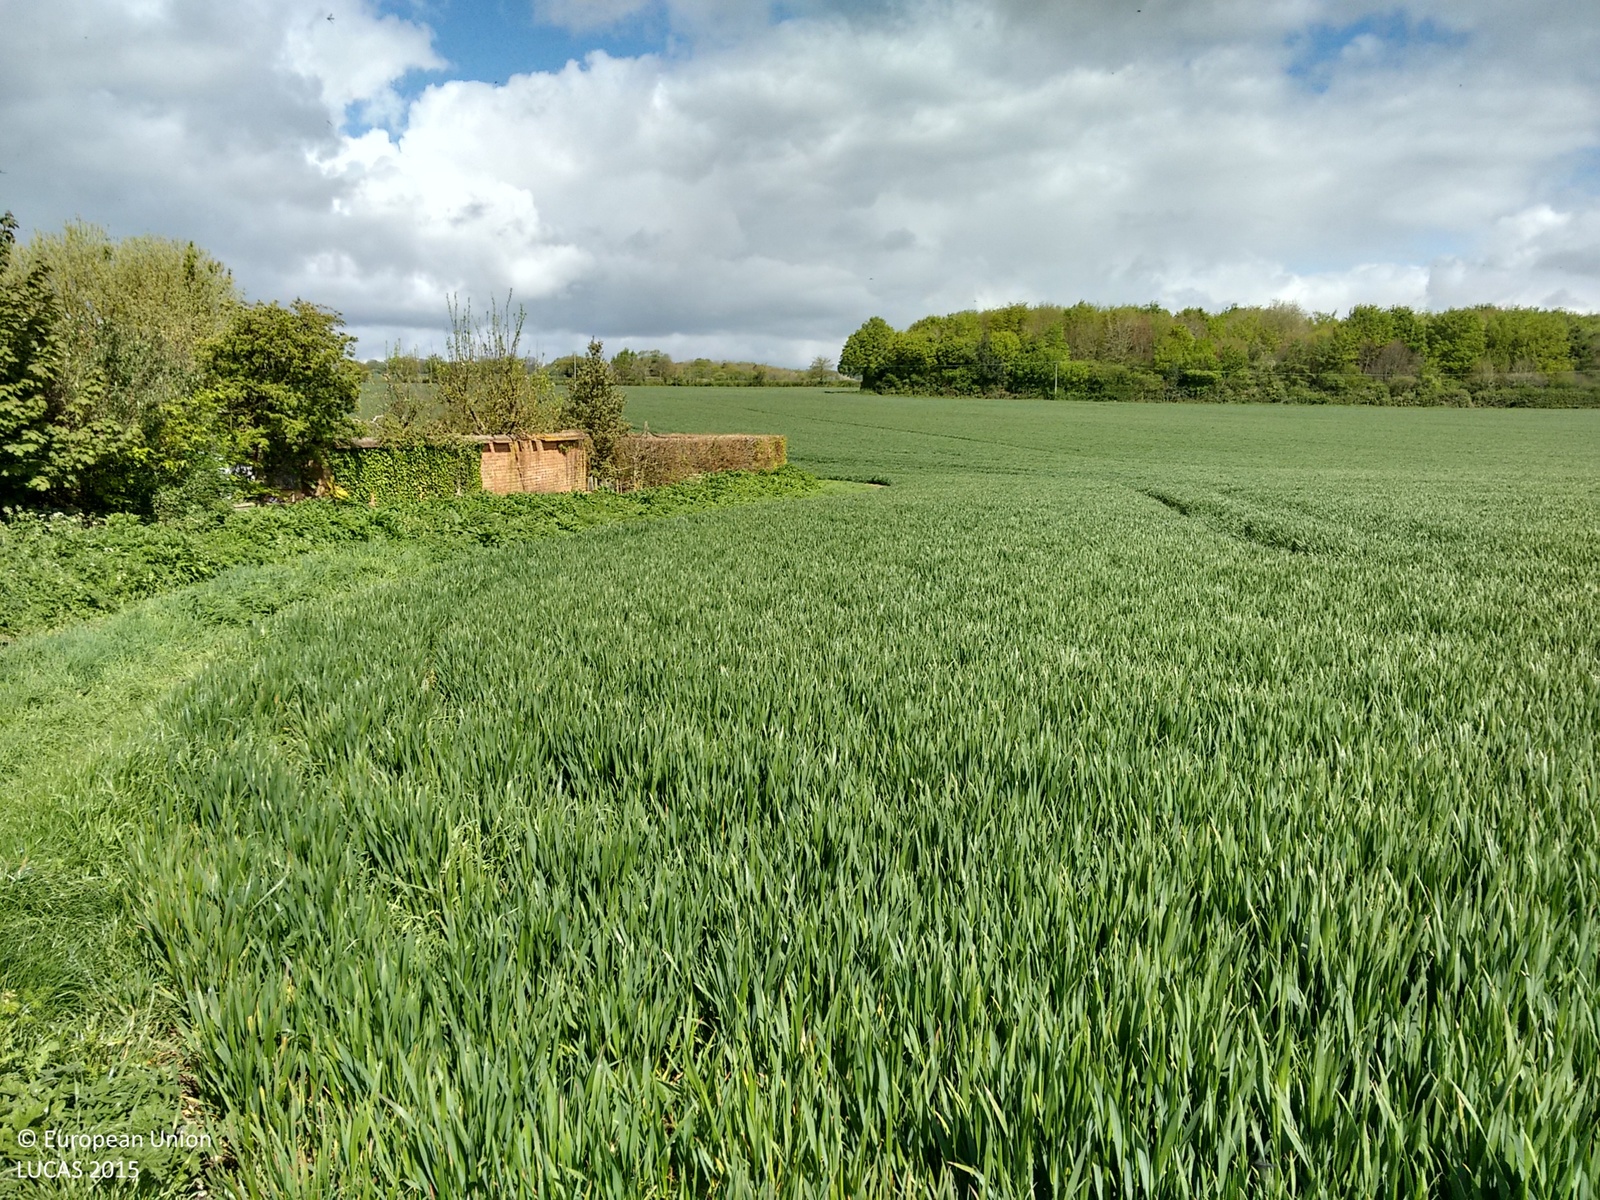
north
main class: Cropland
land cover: Common wheat
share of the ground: > 75 %
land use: Agriculture (excluding fallow land and kitchen gardens)
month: May
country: GB
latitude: 51.2534
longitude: -1.4993
